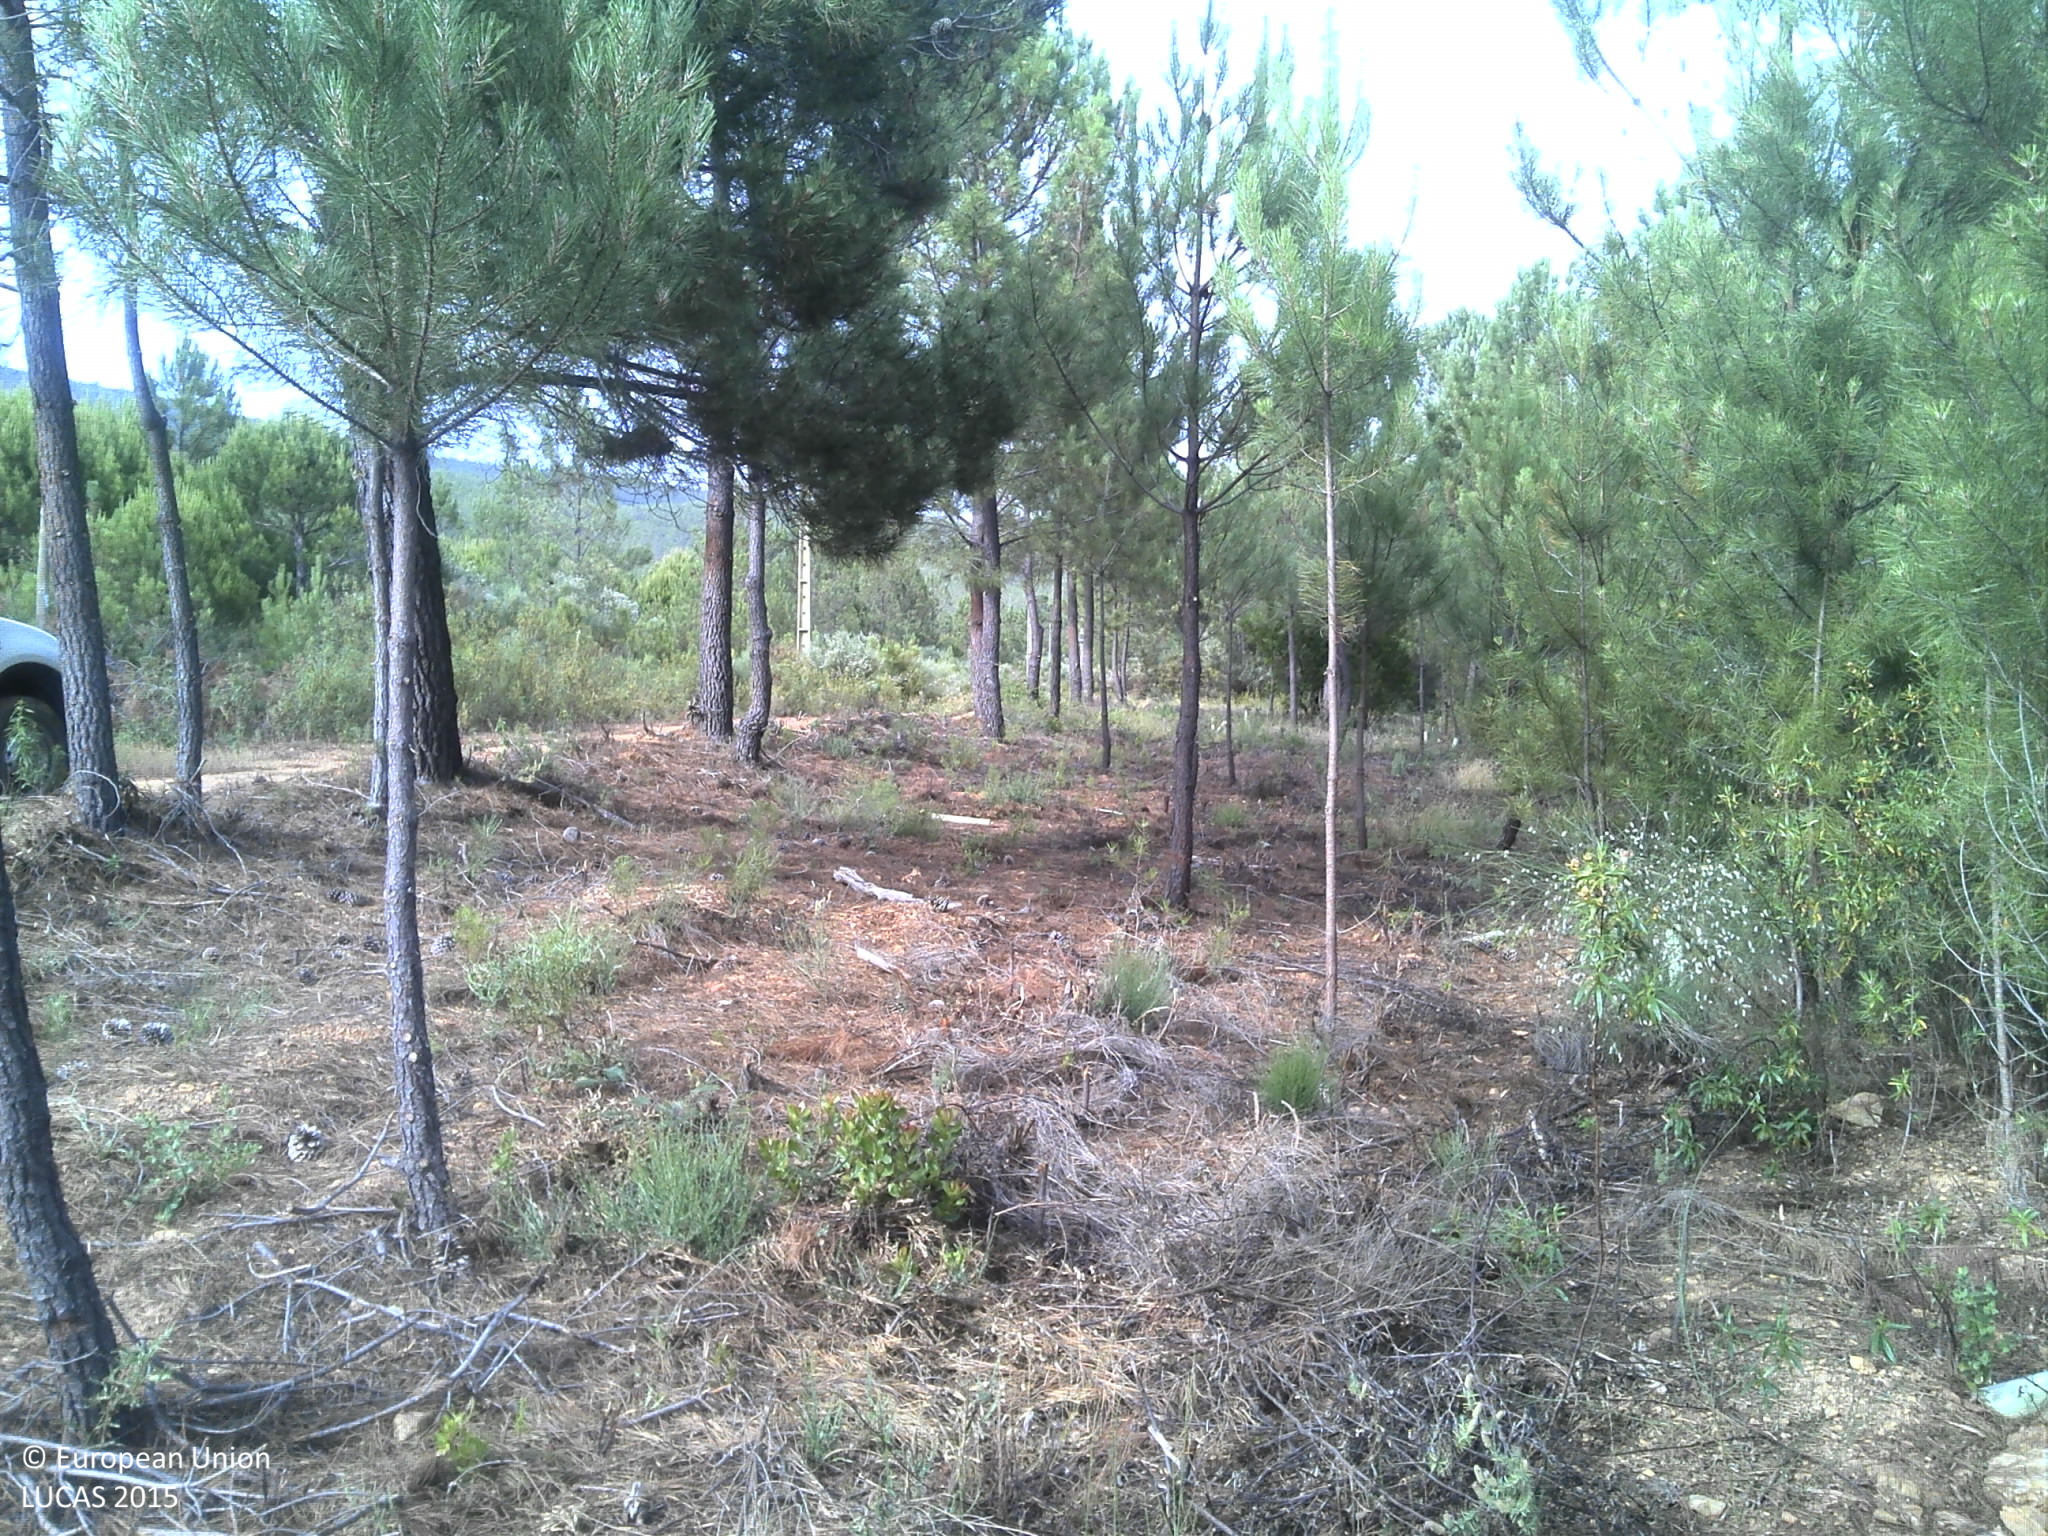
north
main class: Woodland
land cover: Pine dominated coniferous woodland
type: coniferous forest of the mediterranean region
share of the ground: 50 - 75 %
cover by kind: coniferous forest trees 50 %, shrubs 40 %, unconsolidated bare surface 5 %
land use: Forestry
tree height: > 5 m
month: June
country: PT
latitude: 40.2108
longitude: -7.0978
